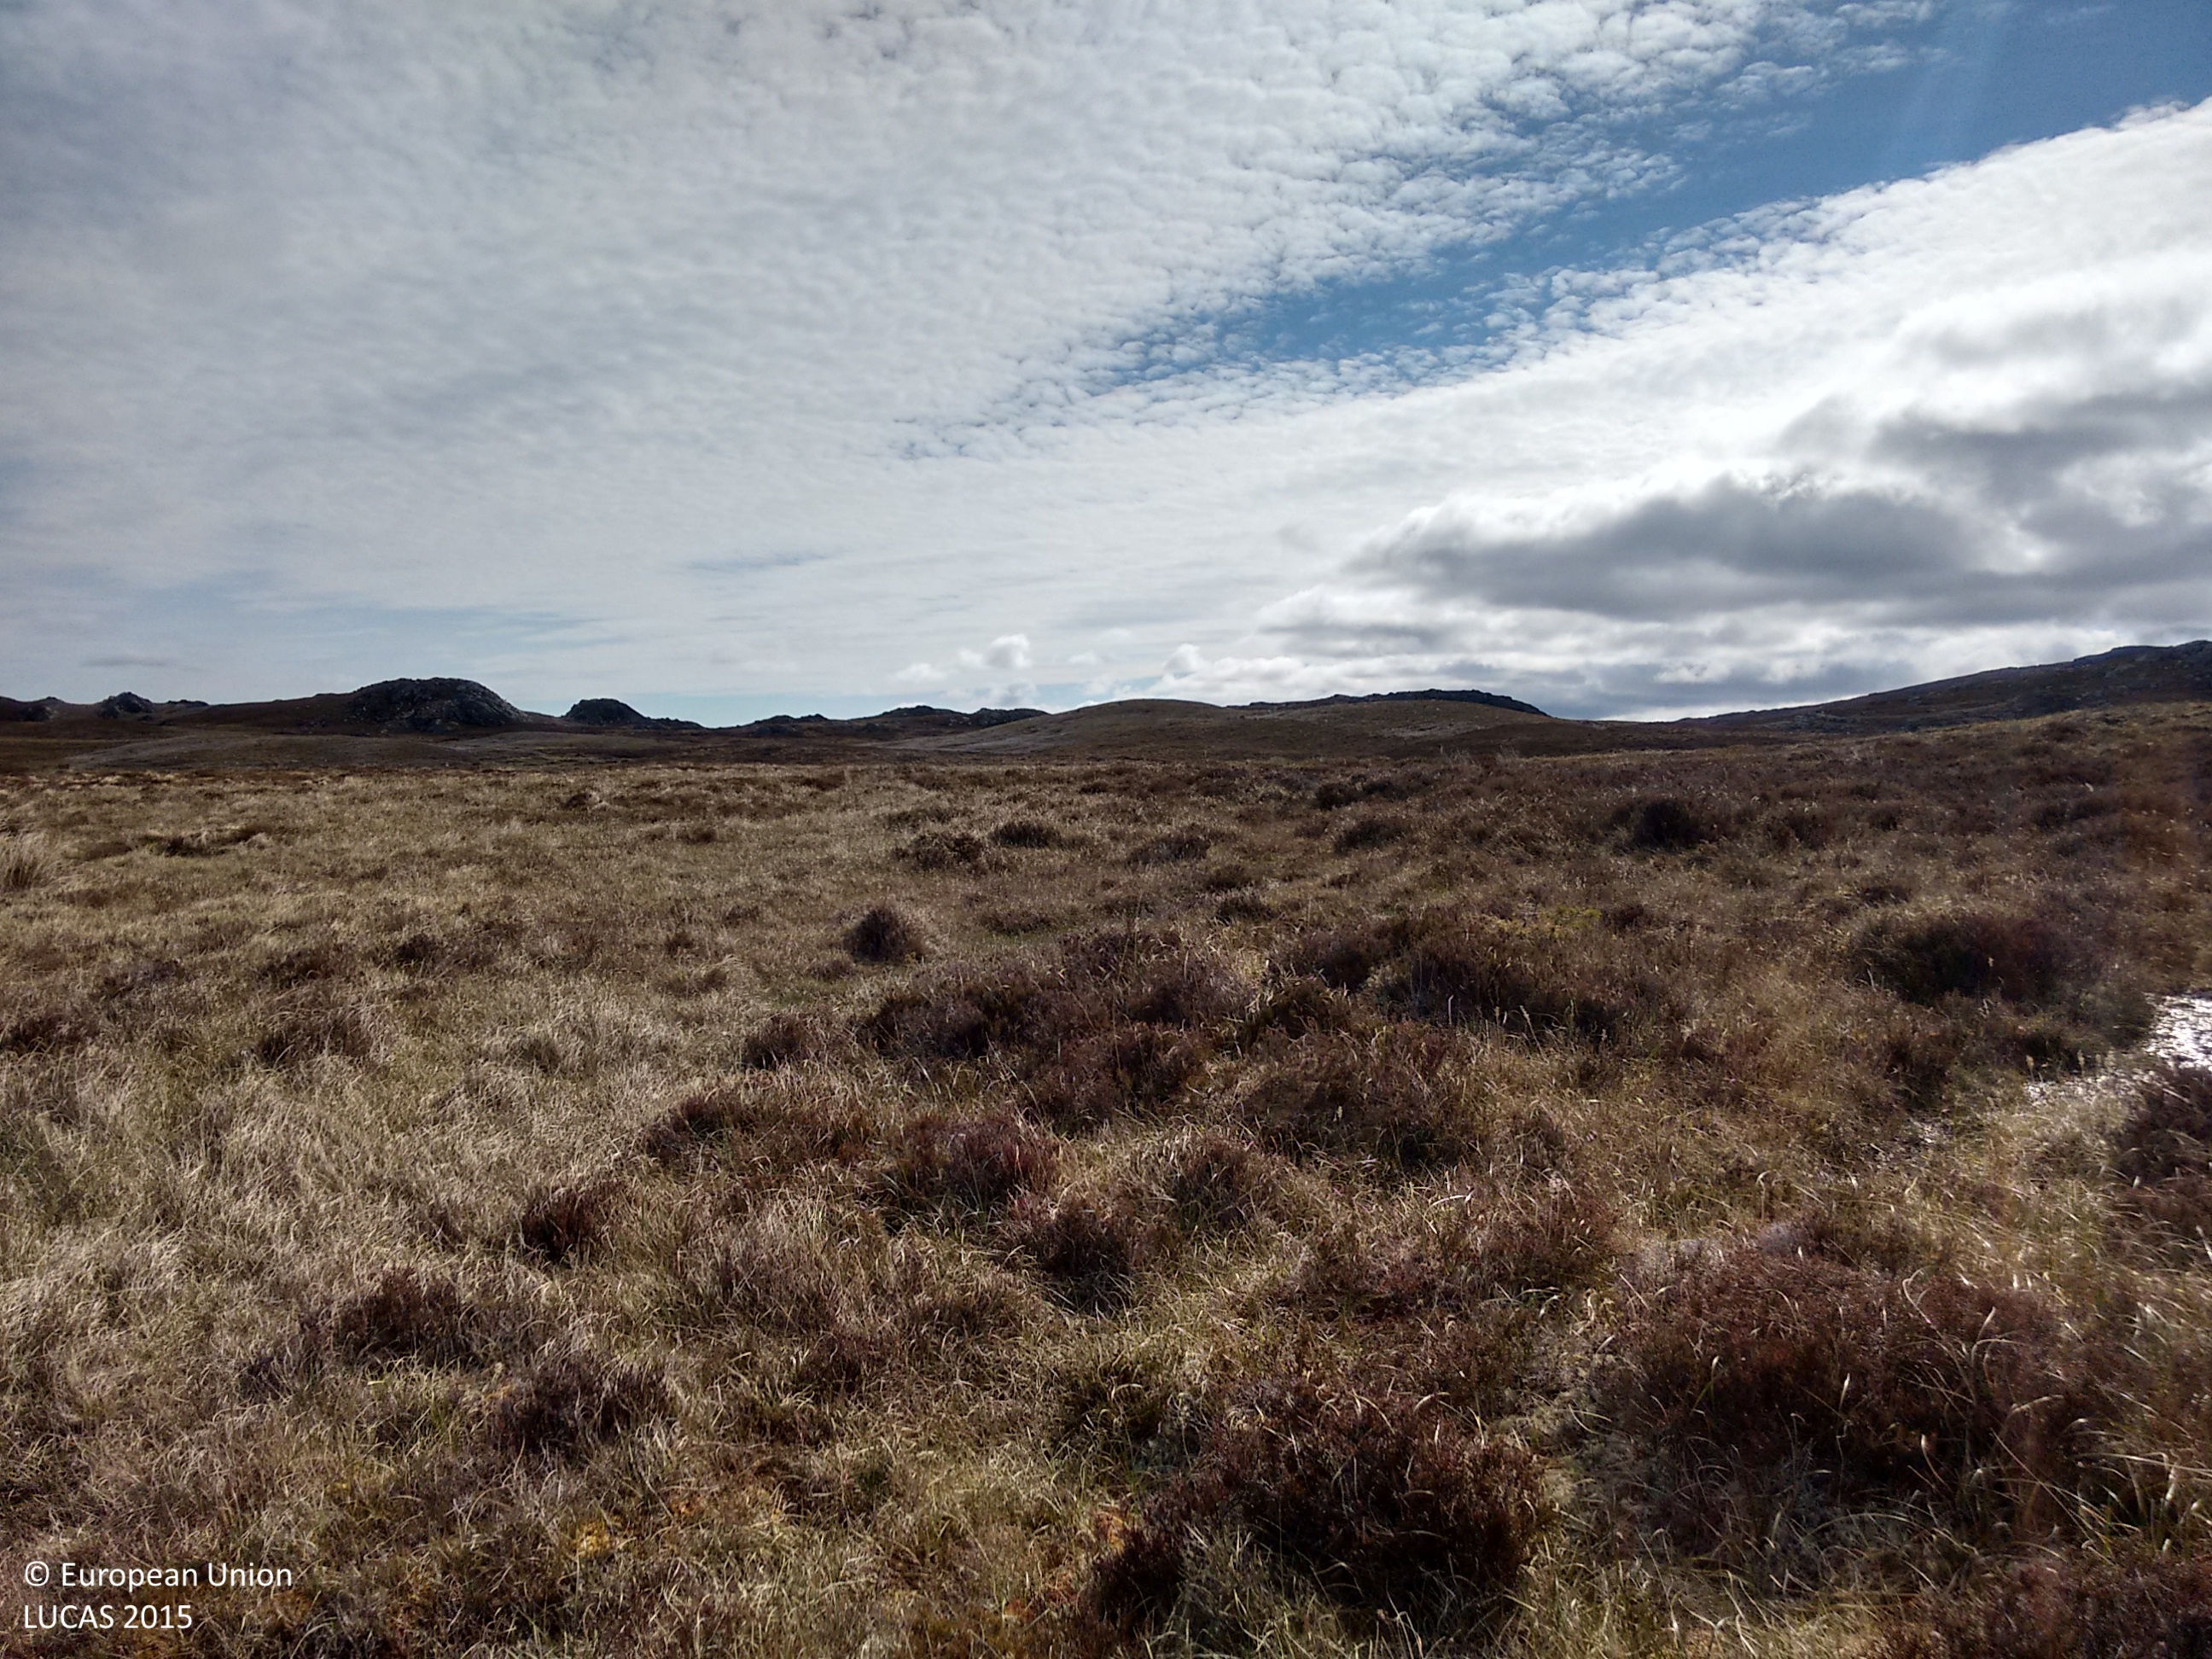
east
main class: Shrubland
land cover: Shrubland without tree cover
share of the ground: > 75 %
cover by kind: shrubs 50 %, herbaceous plants 40 %, lichens and mosses 10 %
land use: Agriculture (excluding fallow land and kitchen gardens)
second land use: Other primary production
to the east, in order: Shrubland without tree cover; Grassland without tree/shrub cover; Ditches and canals; Spontaneously vegetated surfaces; Shrubland without tree cover; Grassland without tree/shrub cover; Rivers and streams; Grassland without tree/shrub cover; Rivers and streams; Shrubland without tree cover
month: June
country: GB
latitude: 57.3610
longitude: -3.7577
